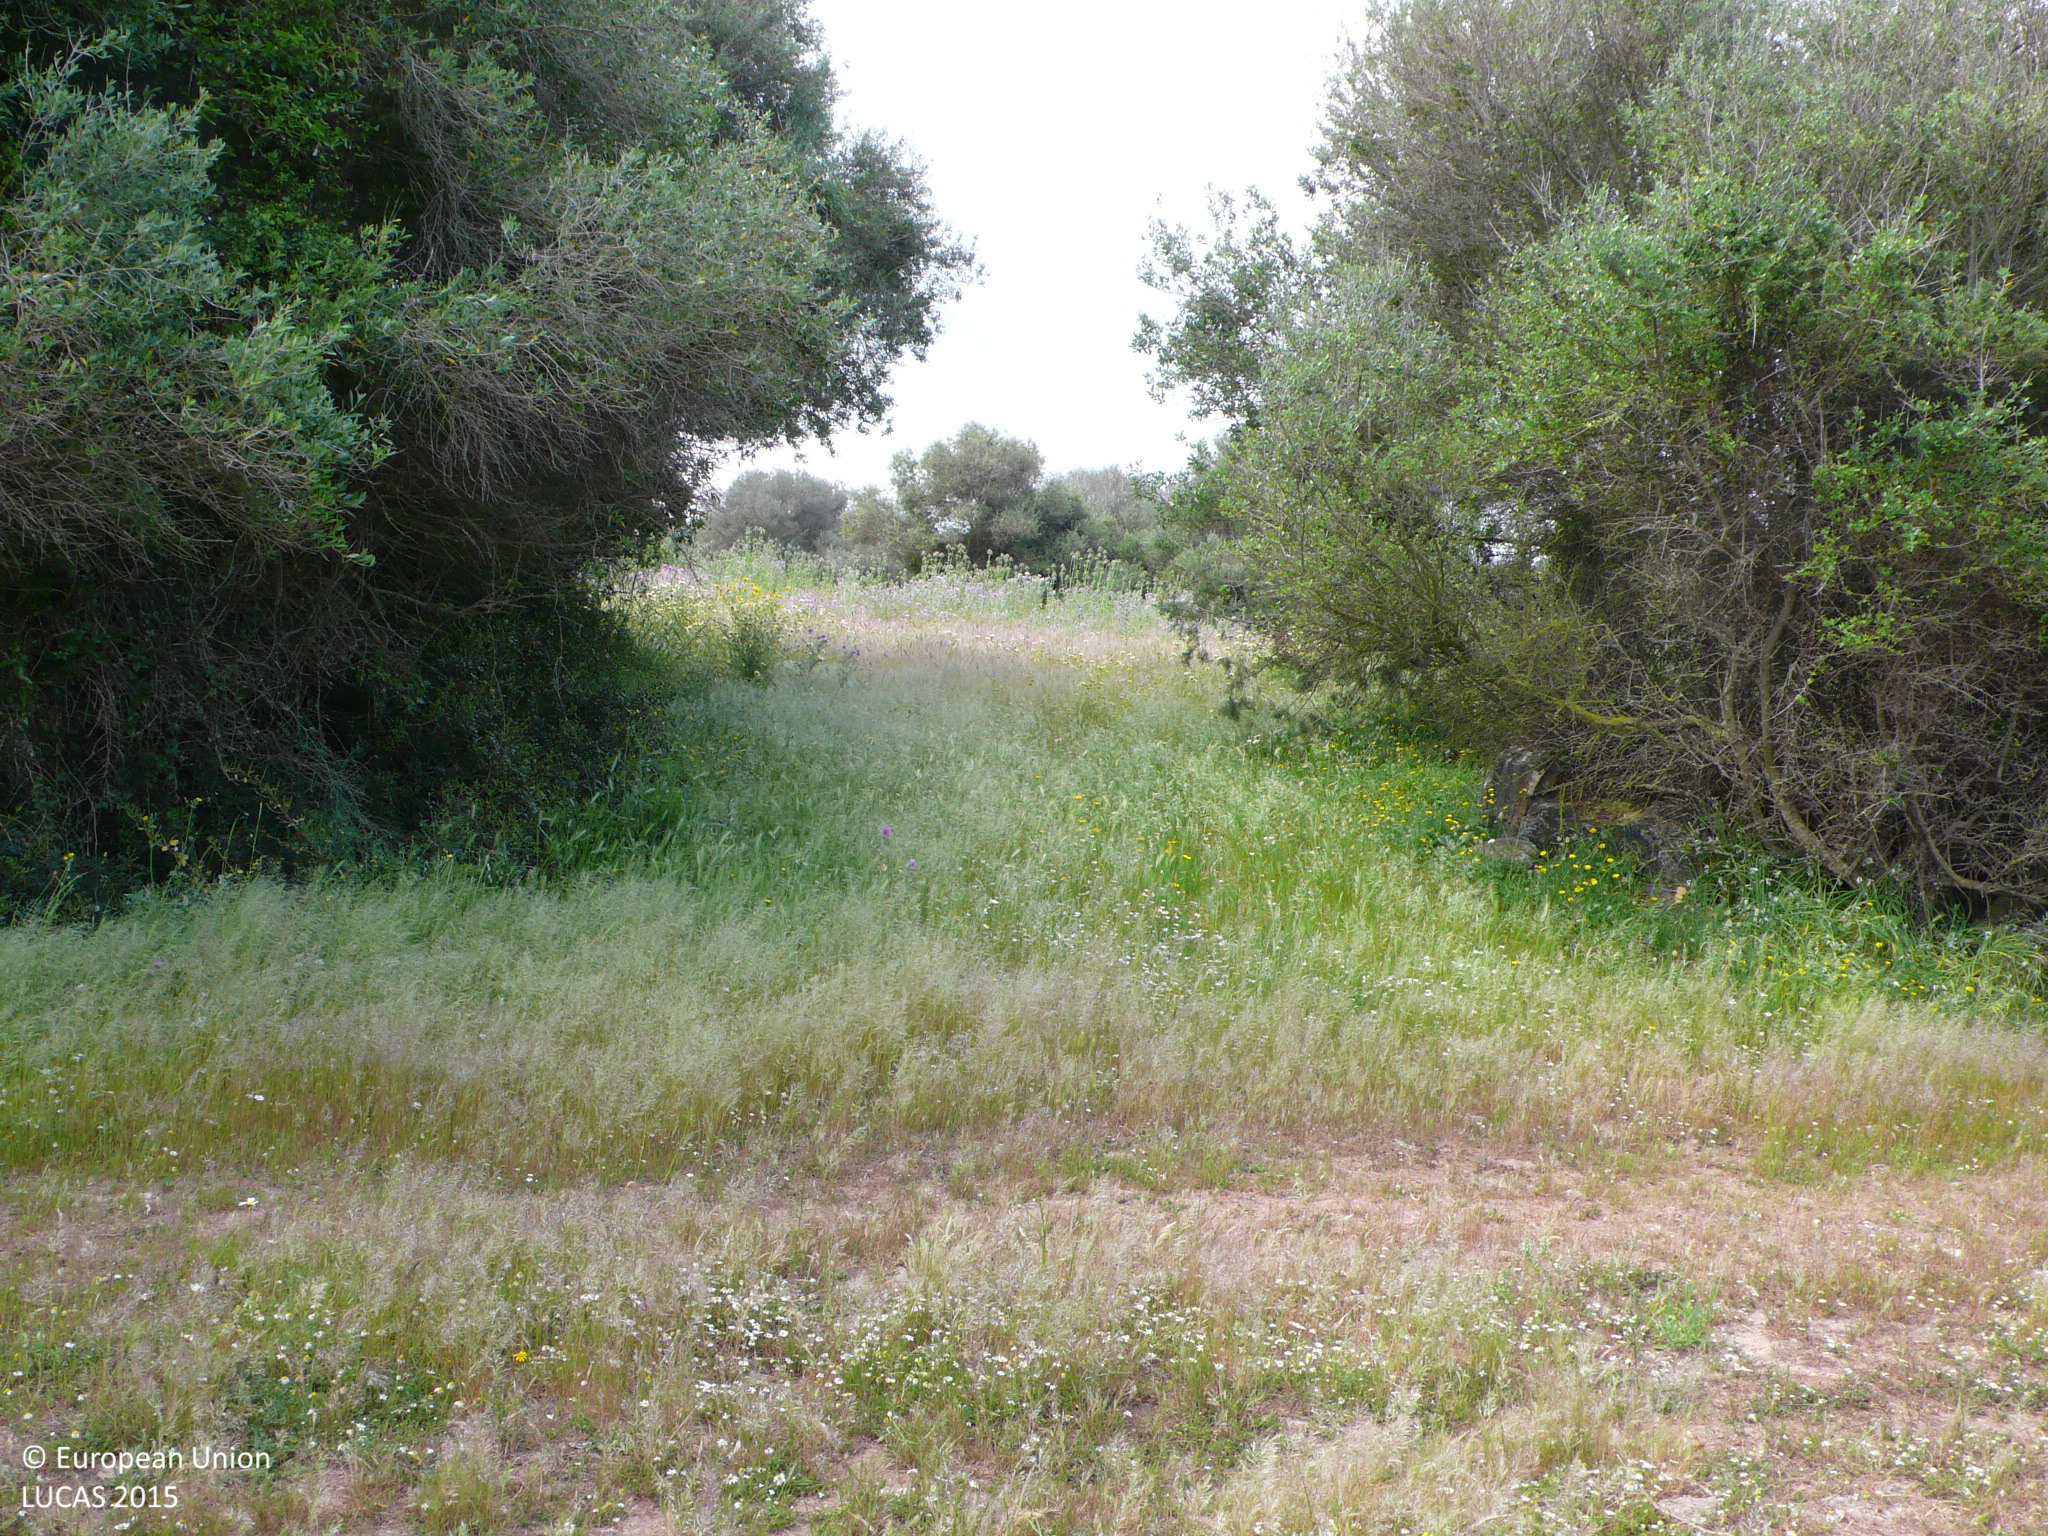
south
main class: Woodland
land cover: Broadleaved woodland
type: broadleaved evergreen forest
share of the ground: 25 - 50 %
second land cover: Grassland without tree/shrub cover
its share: 50 - 75 %
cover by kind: herbaceous plants 50 %, broadleaved forest trees 40 %, shrubs 10 %
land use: Forestry
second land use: Agriculture (excluding fallow land and kitchen gardens)
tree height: > 5 m
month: May
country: ES
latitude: 39.9593
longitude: 4.0442
